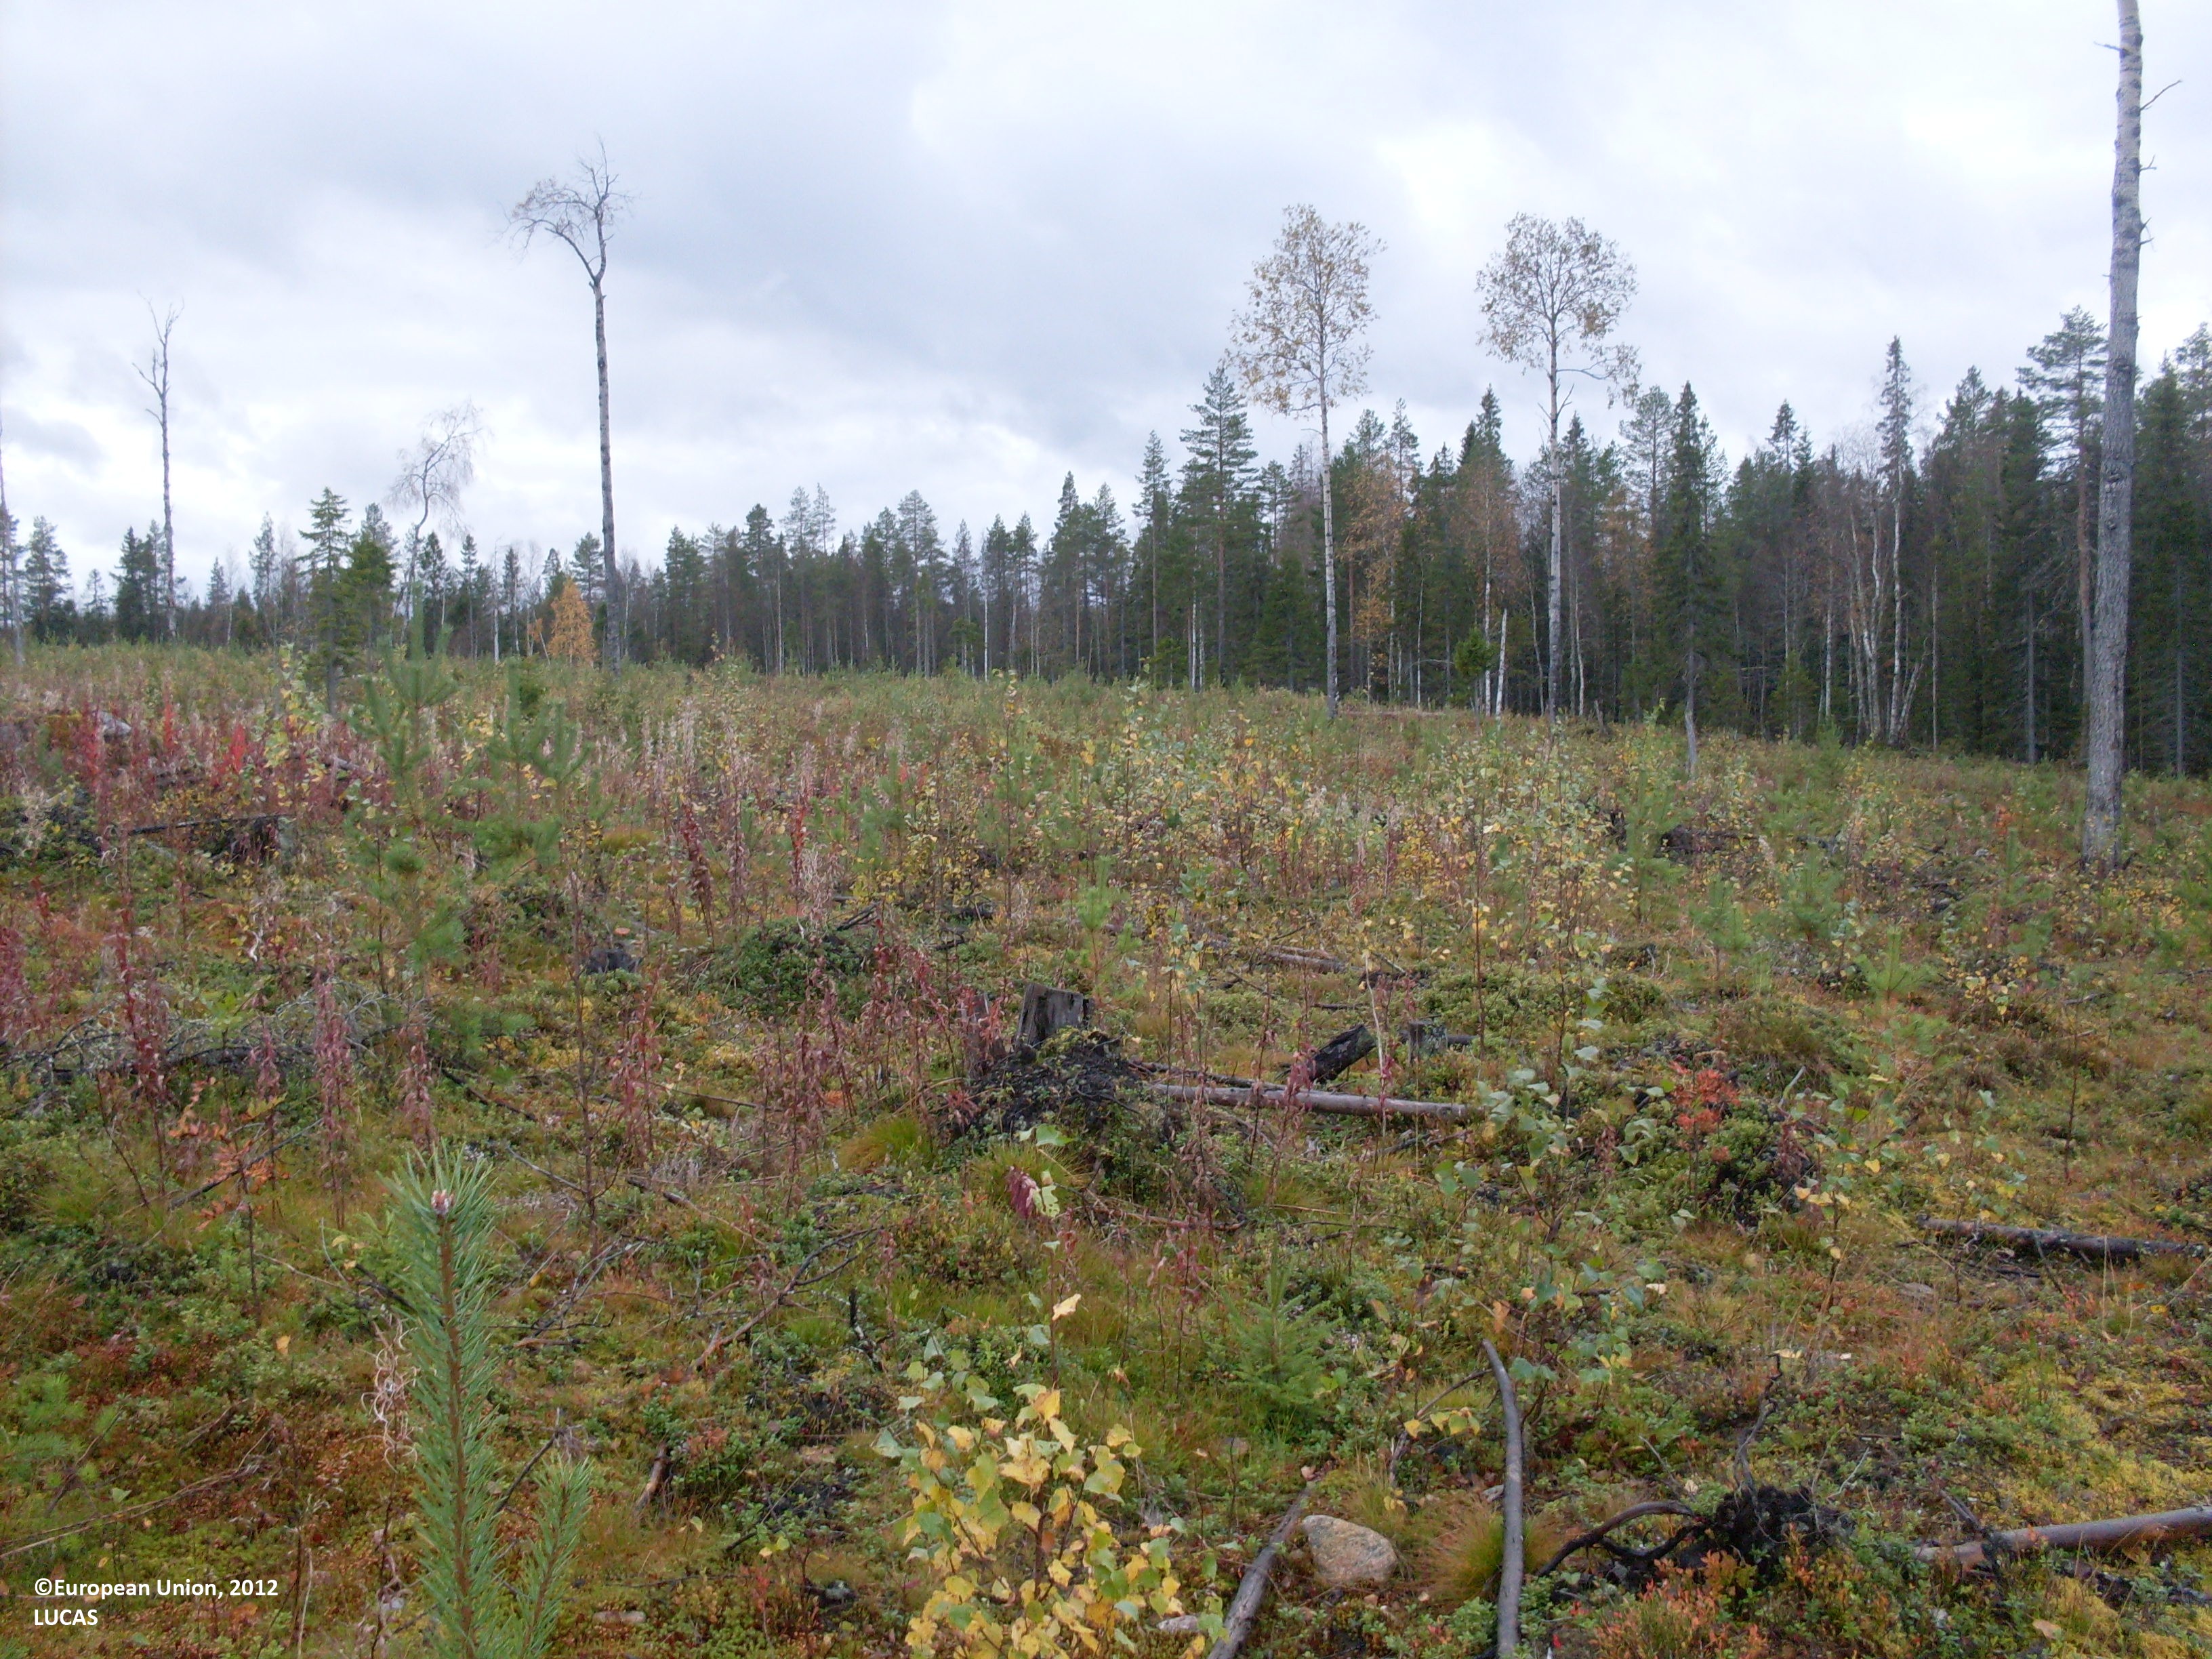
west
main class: Shrubland
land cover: Shrubland with sparse tree cover
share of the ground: 25 - 50 %
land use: Forestry
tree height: < 5 m
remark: Clear cut
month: September
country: FI
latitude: 64.4866
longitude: 28.6813
